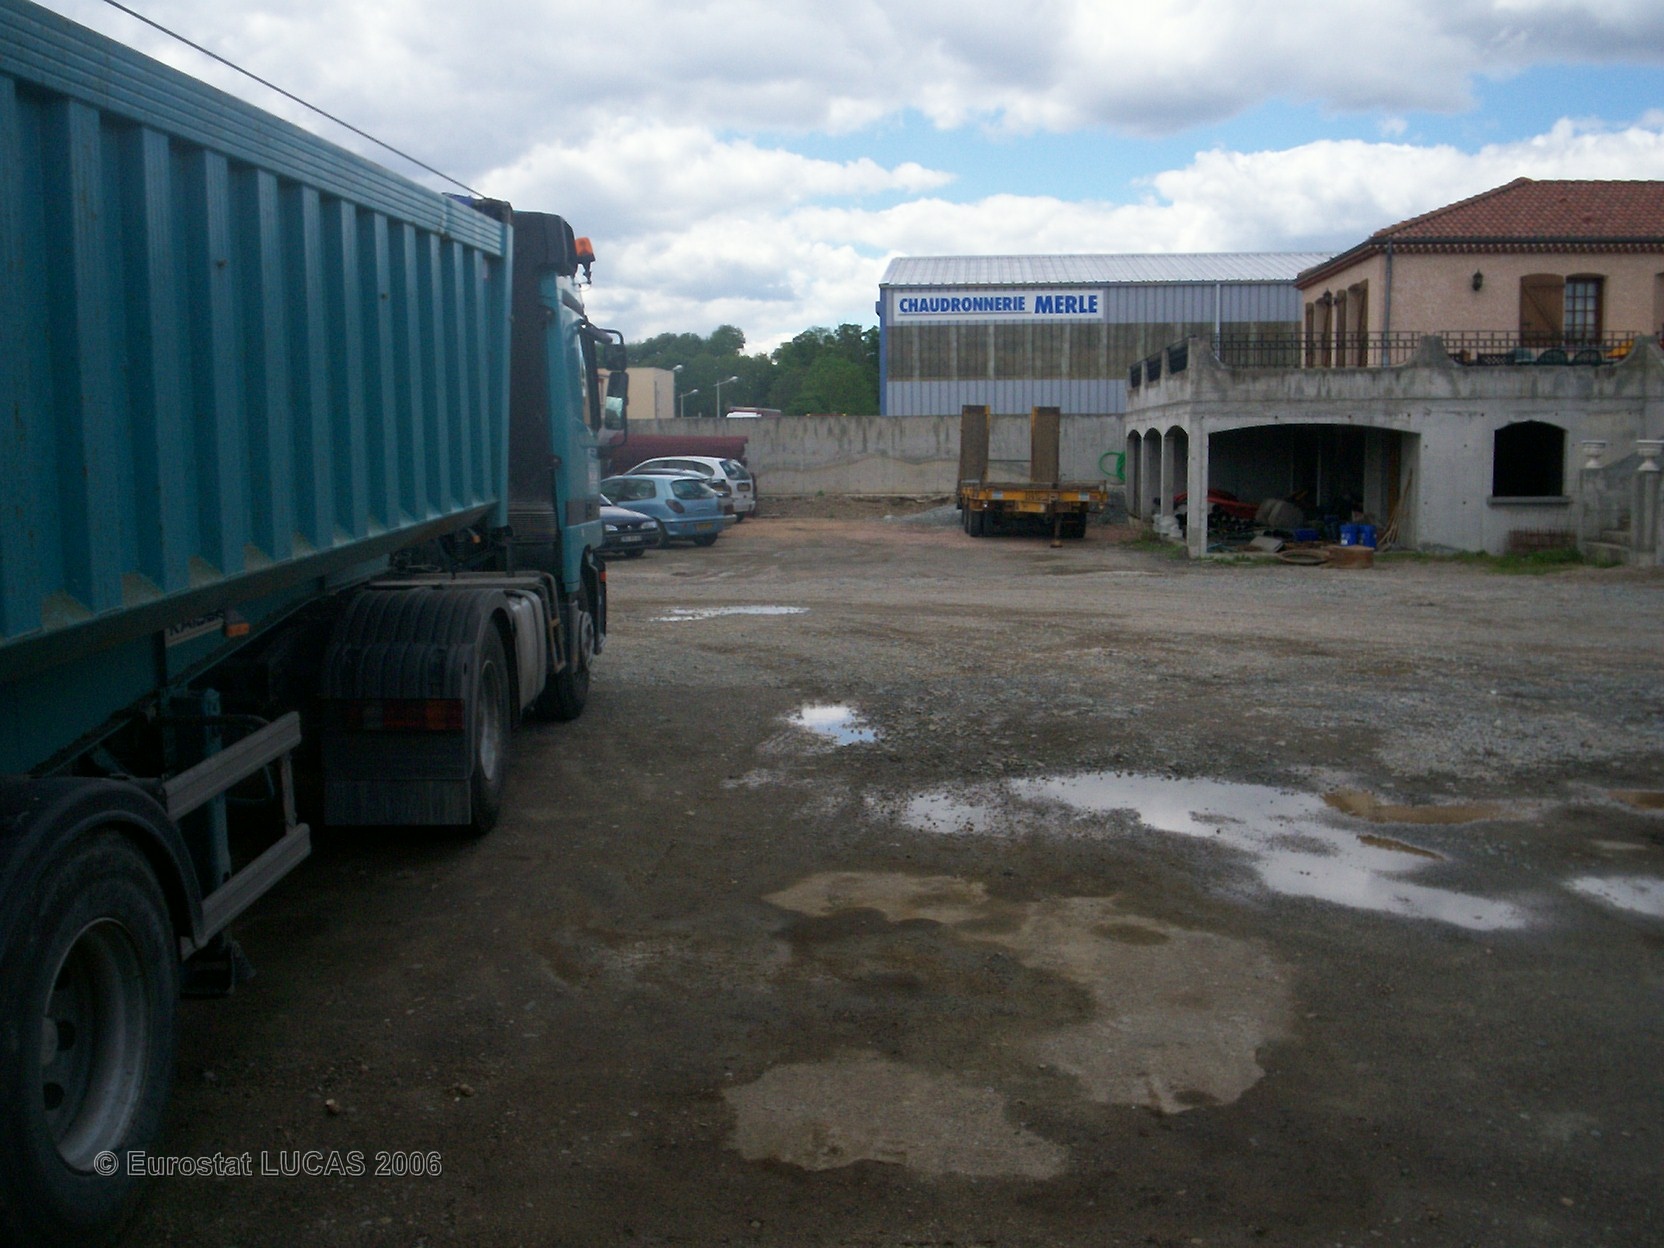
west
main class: Grassland
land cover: Grassland without tree/shrub cover
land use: Residential
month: May
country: FR
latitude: 45.8317
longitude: 3.2673
